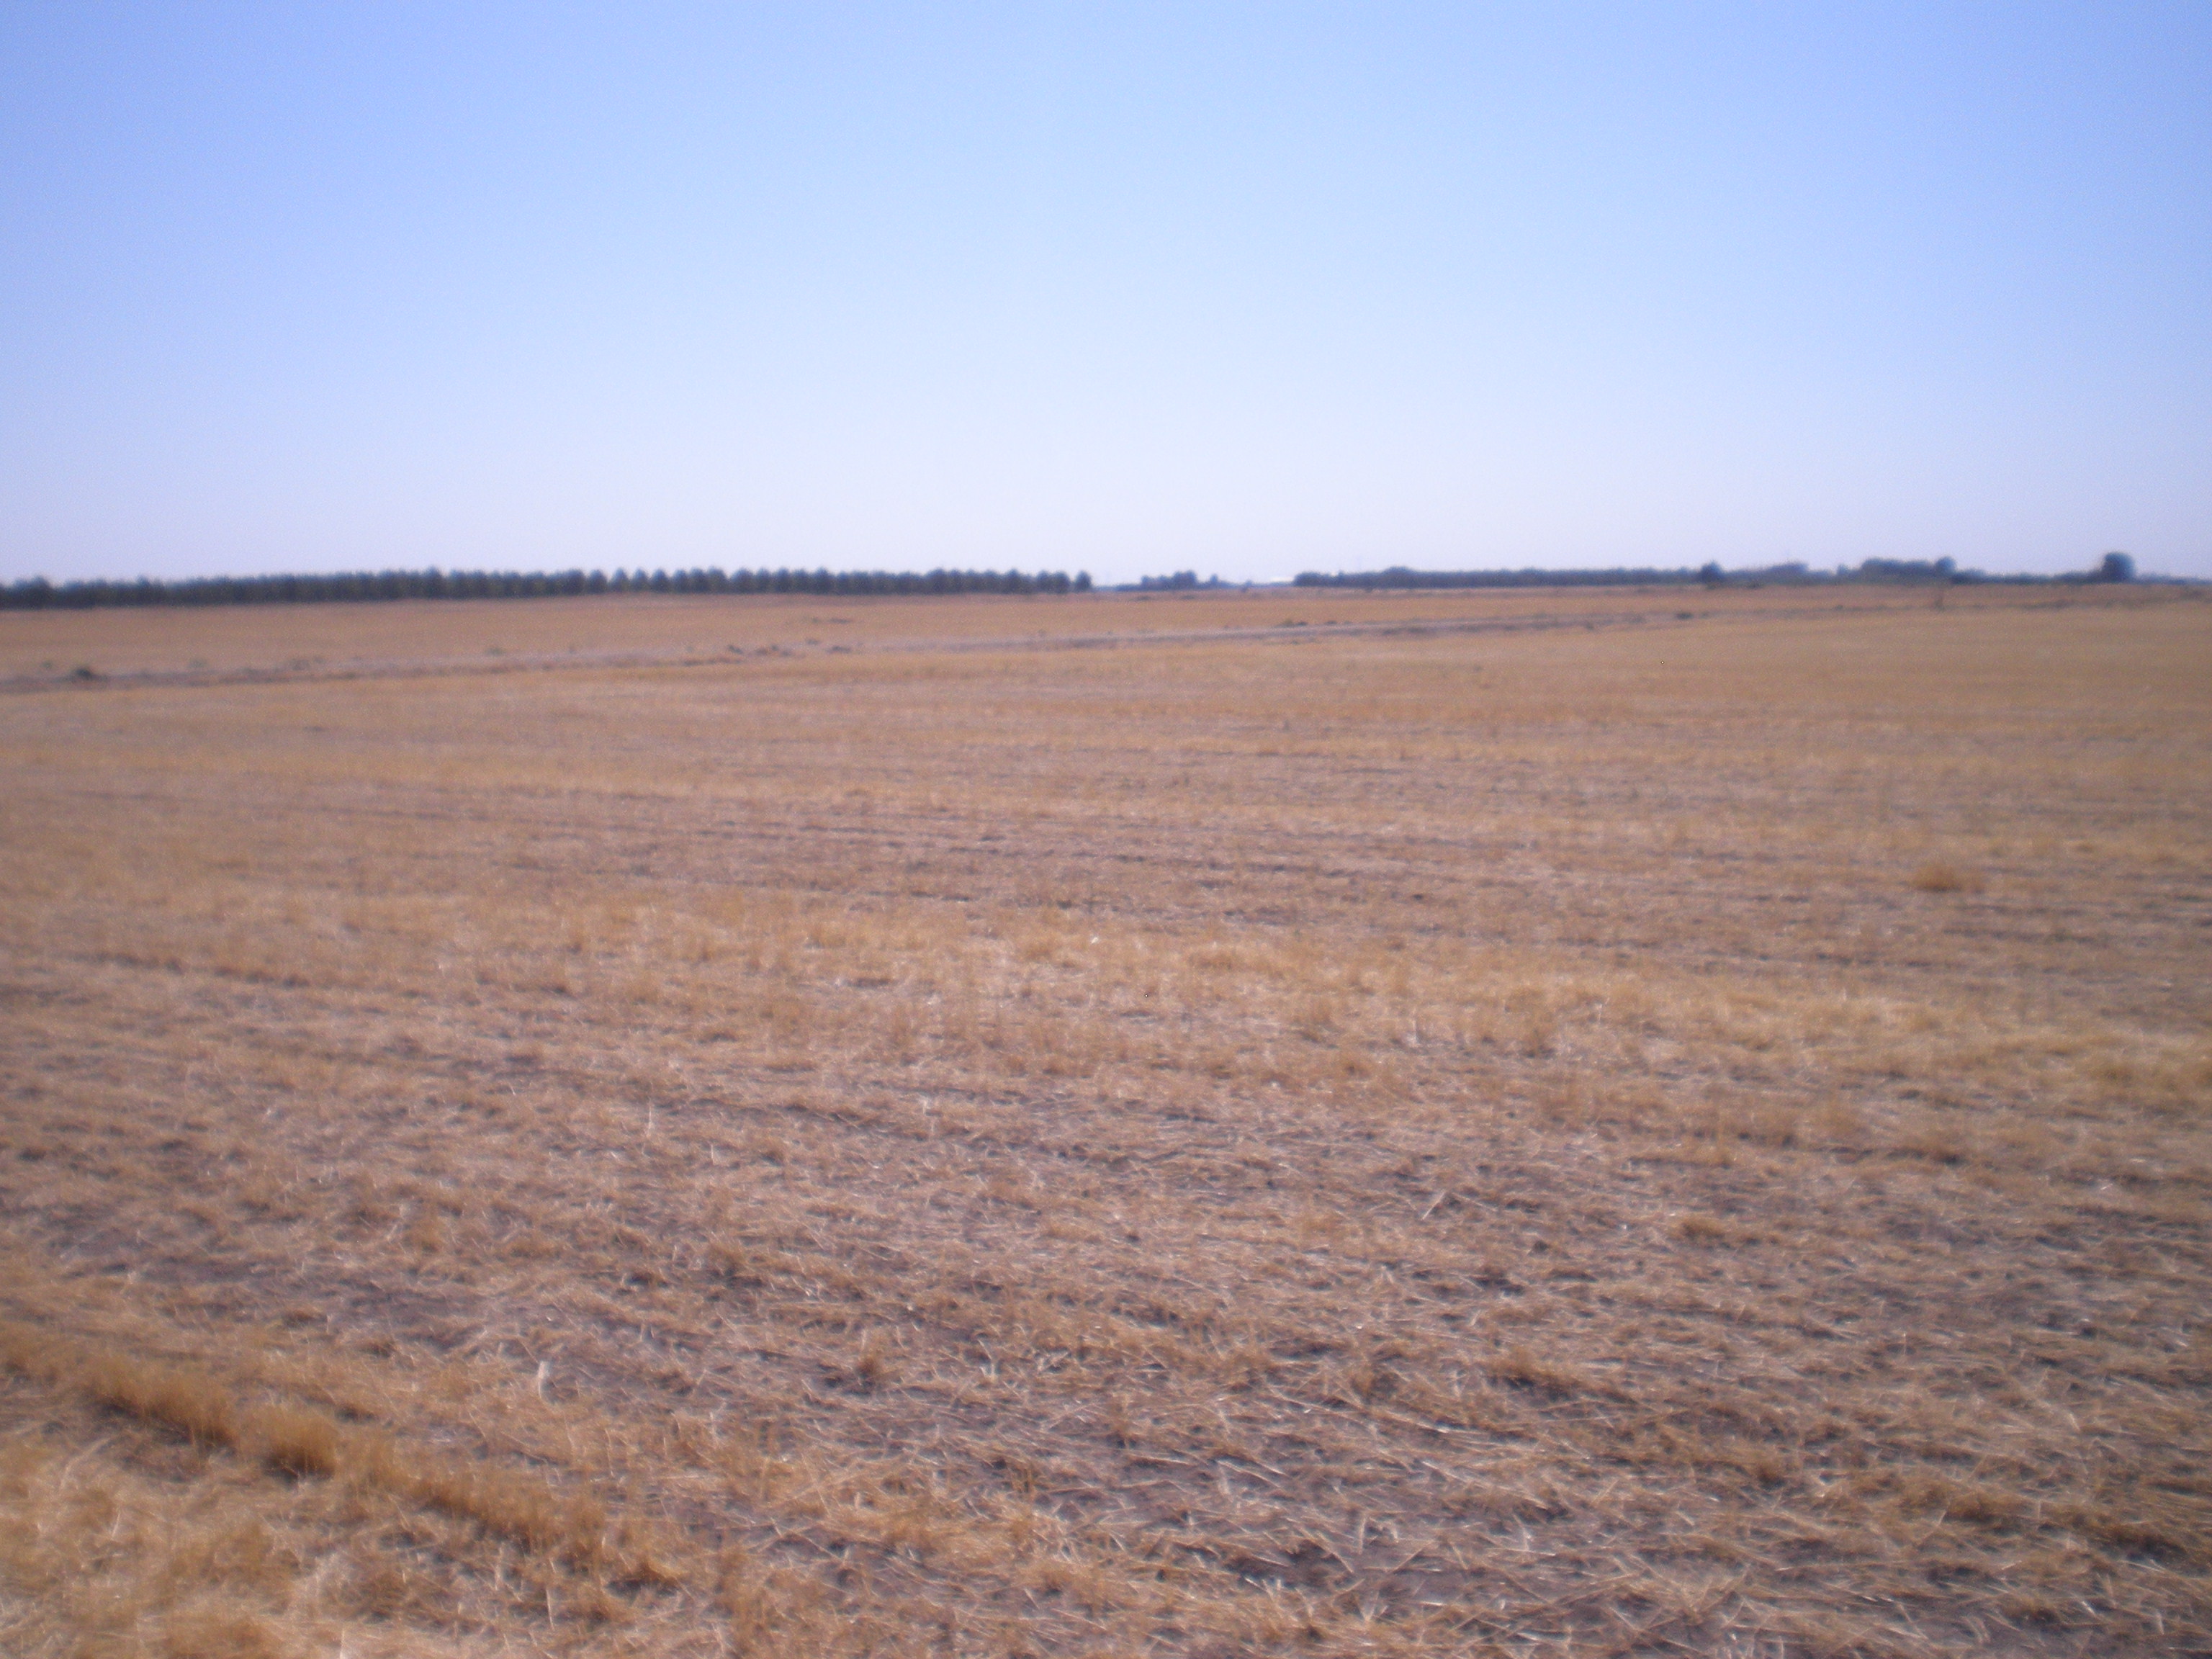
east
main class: Cropland
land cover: Barley
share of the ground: < 10 %
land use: Agriculture (excluding fallow land and kitchen gardens)
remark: Harvested field
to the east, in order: Barley; Grass margins; Tracks; Grass margins; Barley
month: July
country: ES
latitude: 39.3272
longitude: -3.2534
